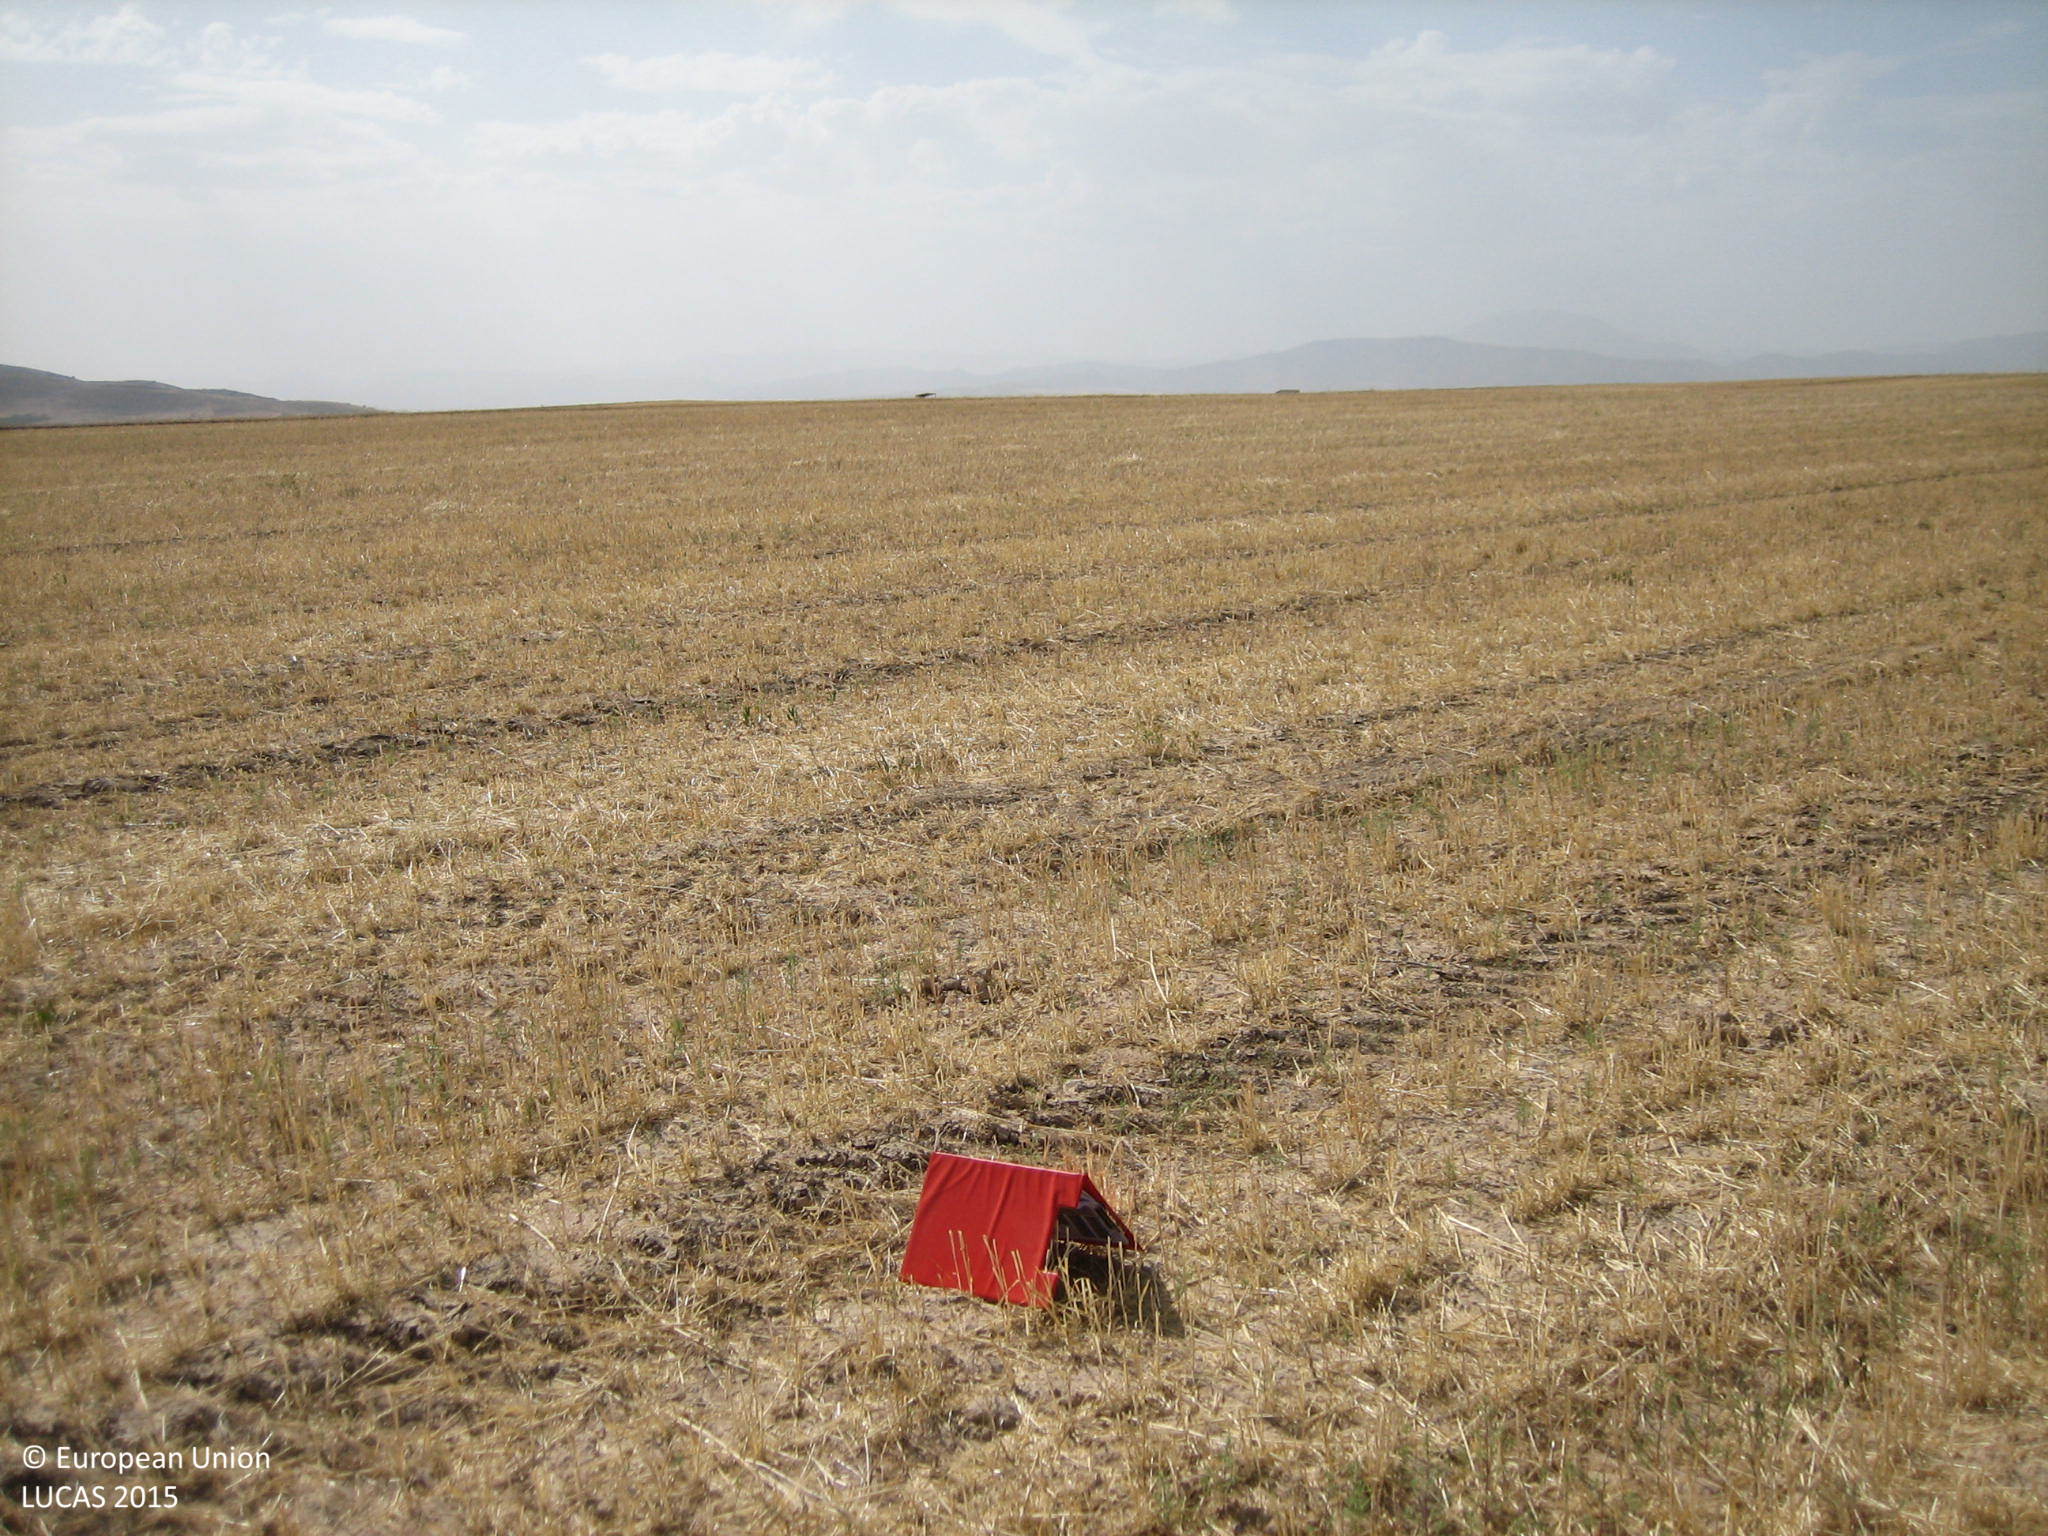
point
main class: Cropland
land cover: Barley
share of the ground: < 10 %
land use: Agriculture (excluding fallow land and kitchen gardens)
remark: Harvested field
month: July
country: ES
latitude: 37.7100
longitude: -2.3400
